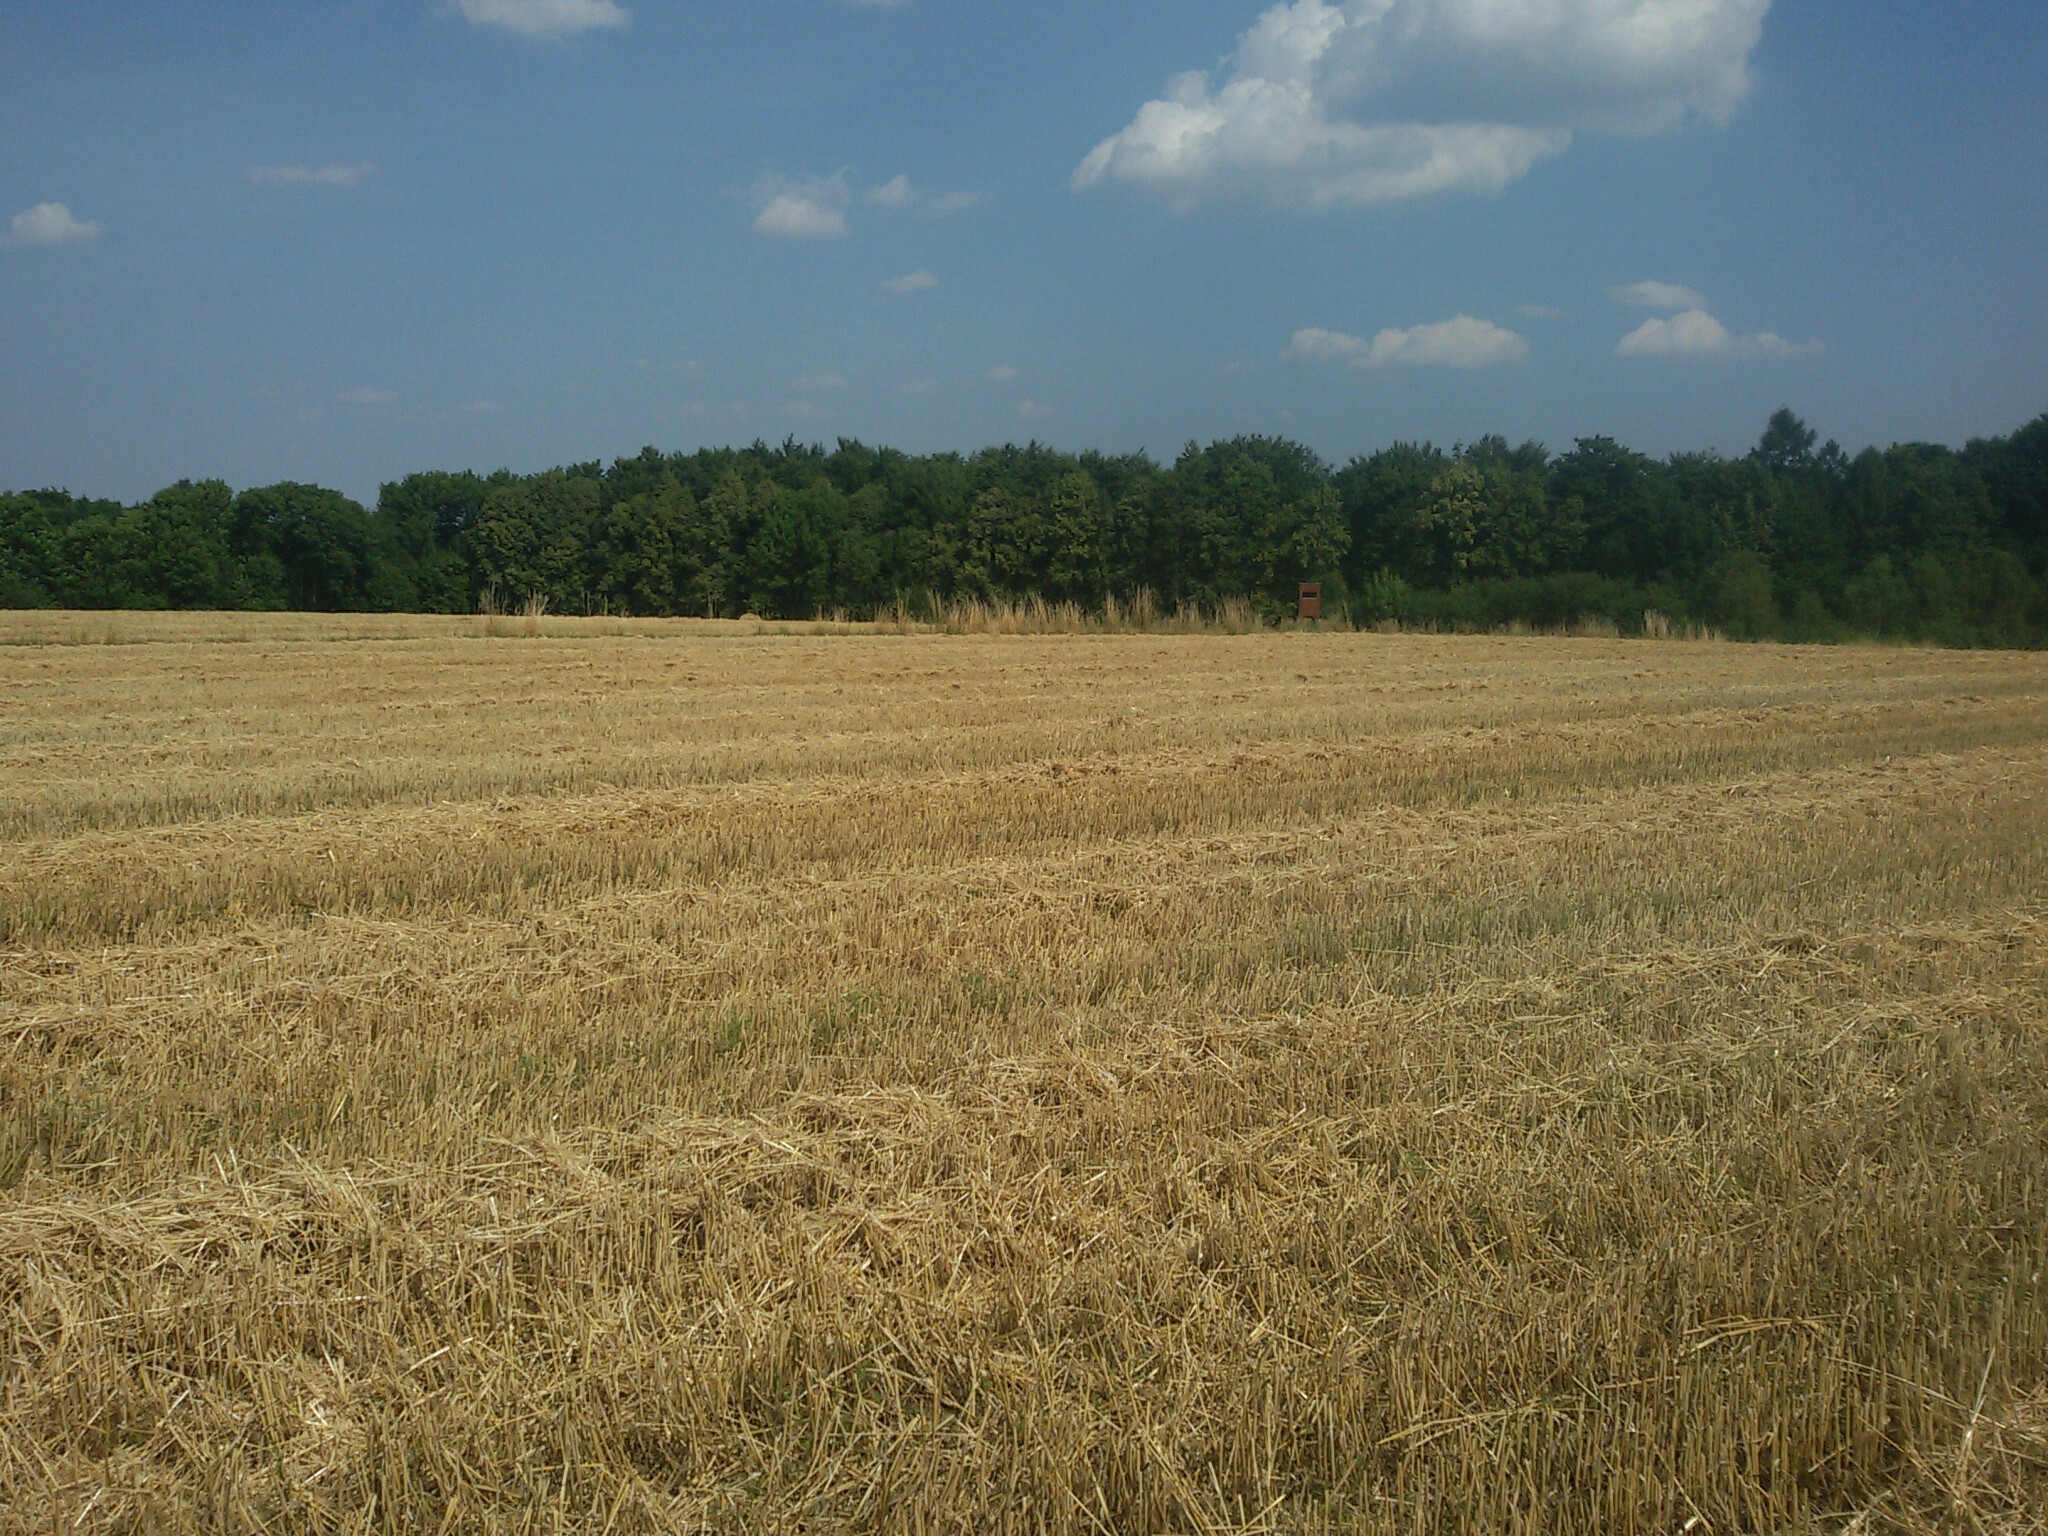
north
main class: Cropland
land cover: Common wheat
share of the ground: > 75 %
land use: Agriculture (excluding fallow land and kitchen gardens)
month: August
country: PL
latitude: 51.0802
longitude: 15.4712
